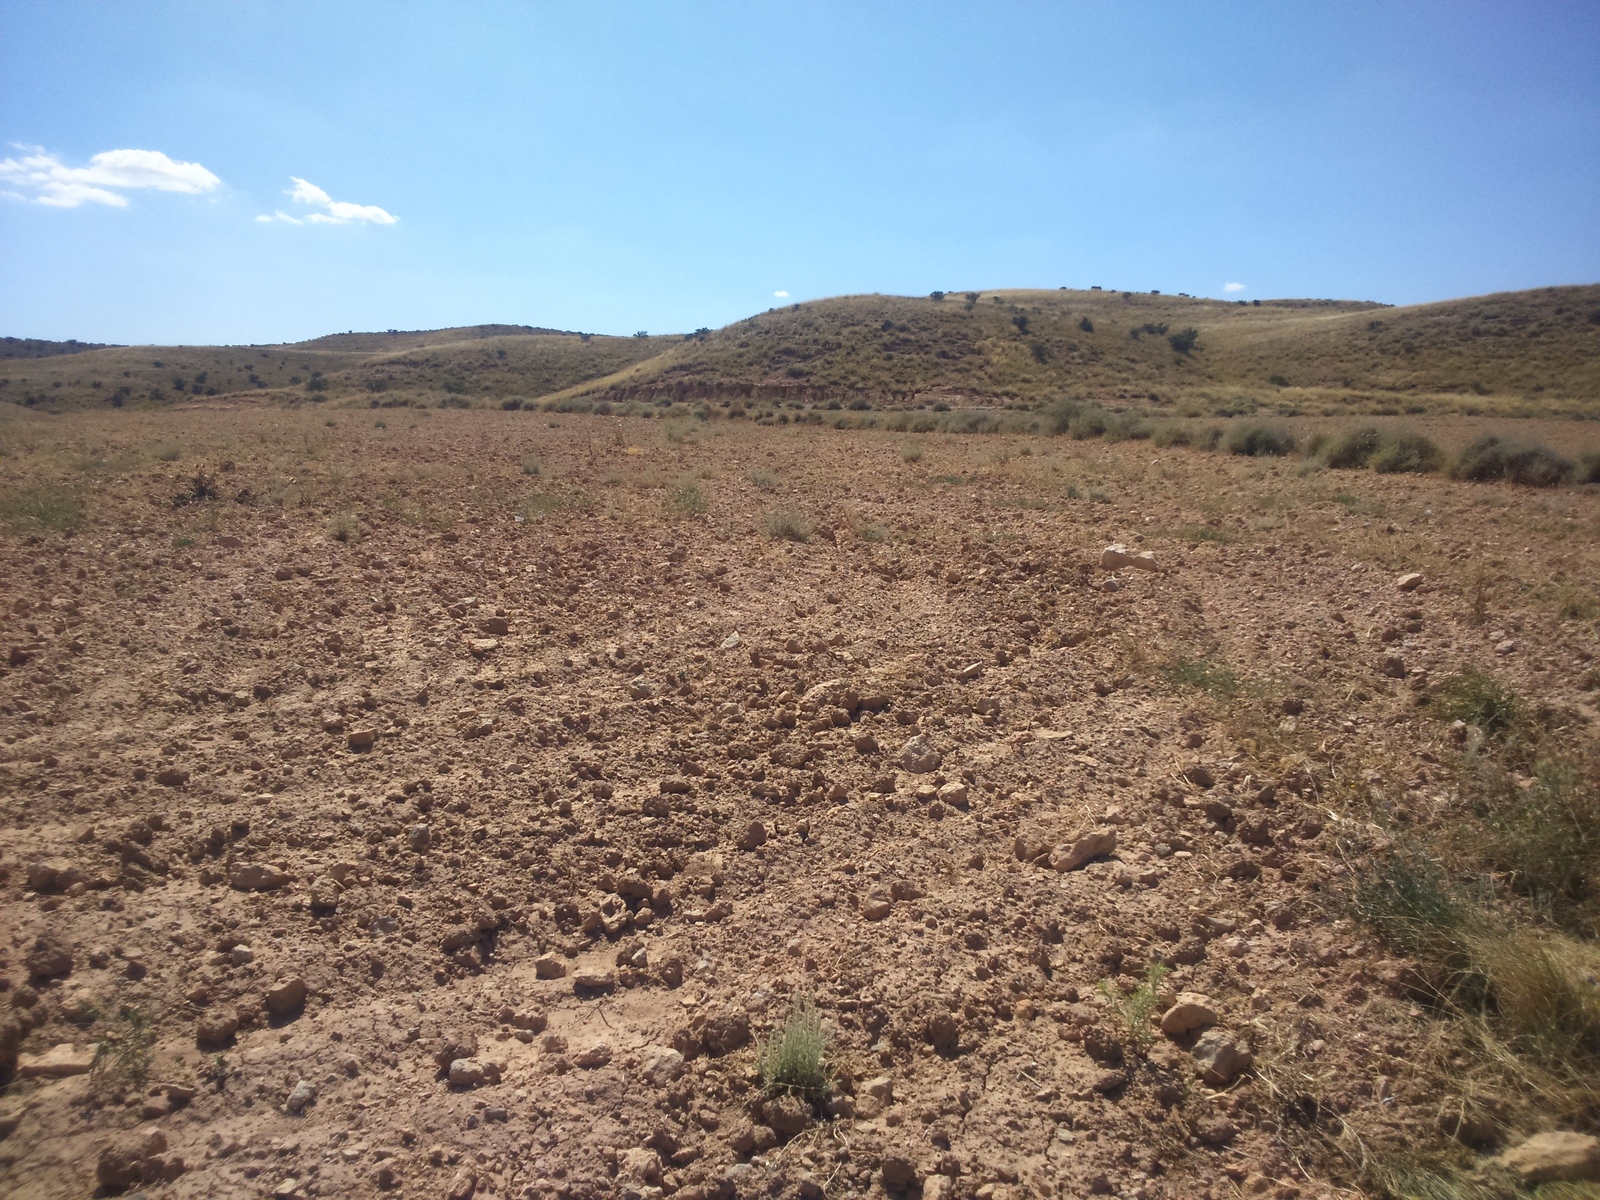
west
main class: Grassland
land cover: Spontaneously vegetated surfaces
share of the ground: 50 - 75 %
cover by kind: herbaceous plants 75 %, lichens and mosses 20 %, shrubs 5 %
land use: Fallow land
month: June
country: ES
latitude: 41.6385
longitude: 0.0805
